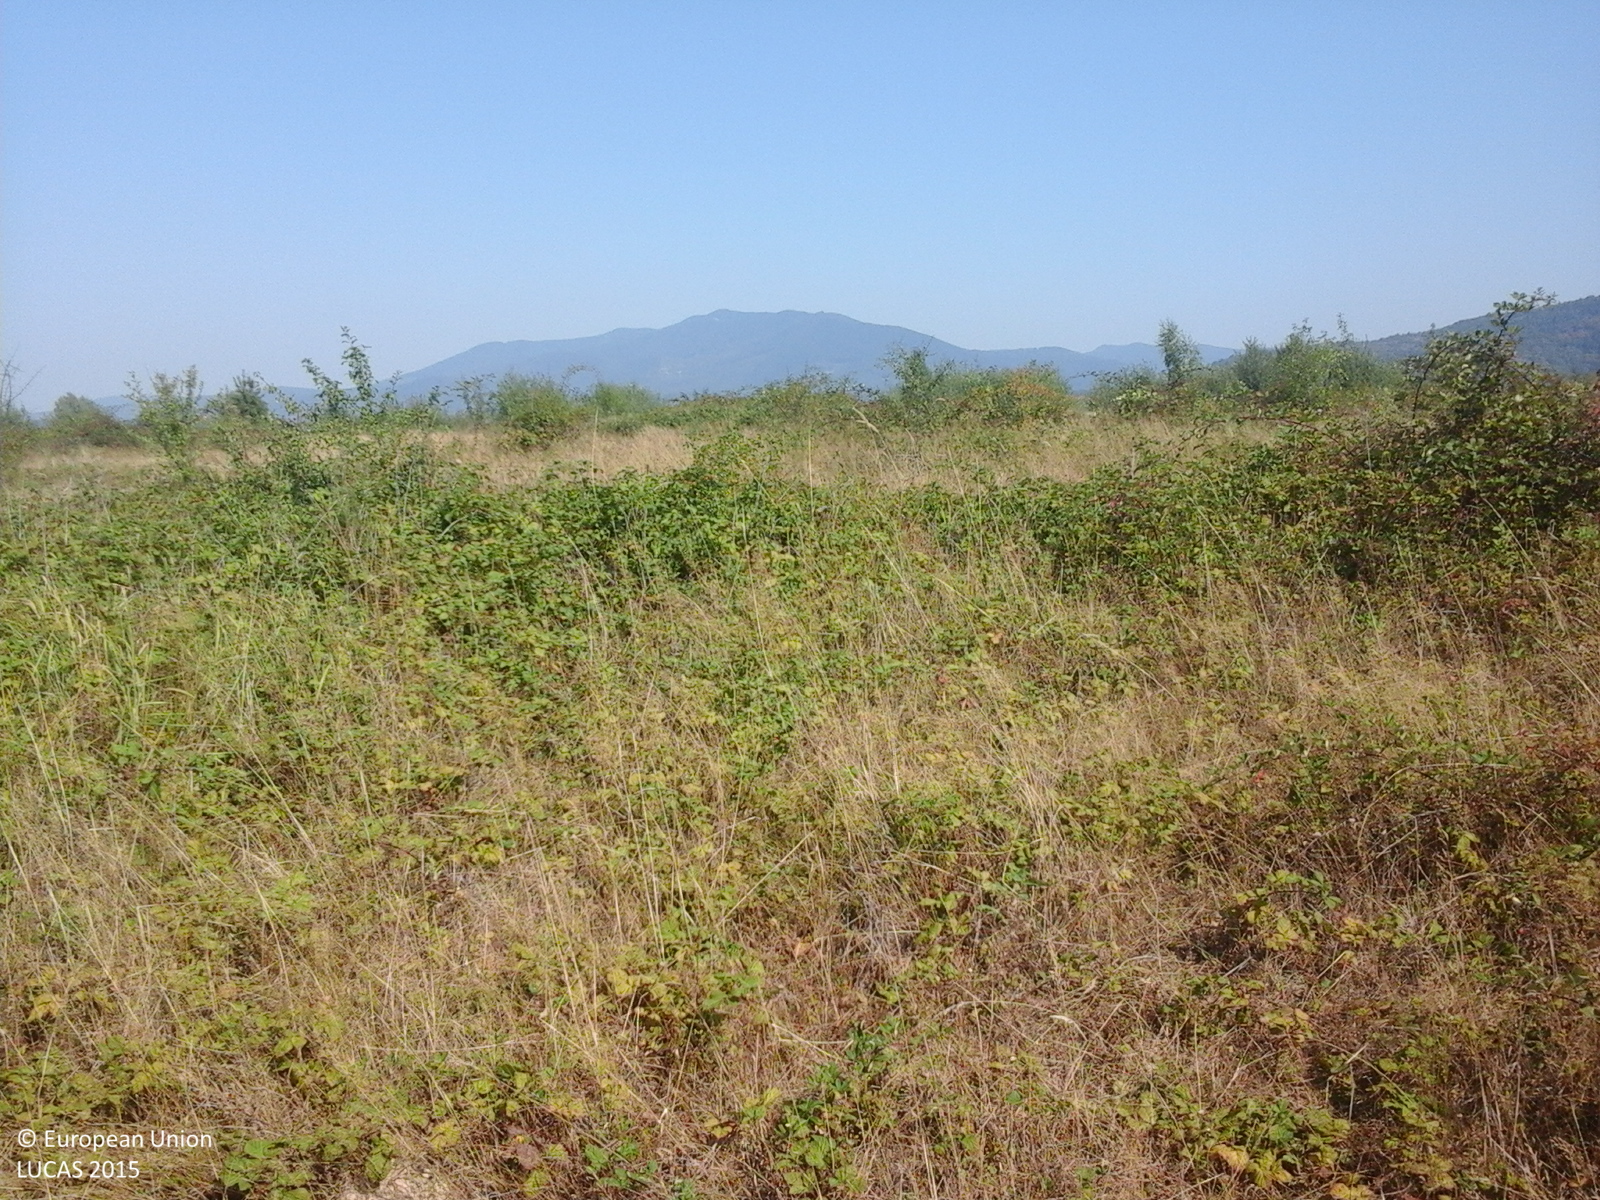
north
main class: Grassland
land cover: Grassland with sparse tree/shrub cover
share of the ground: > 75 %
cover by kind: herbaceous plants 85 %, shrubs 10 %, broadleaved forest trees 5 %
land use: Fallow land
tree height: < 5 m
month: August
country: RO
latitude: 46.3926
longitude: 22.2324
